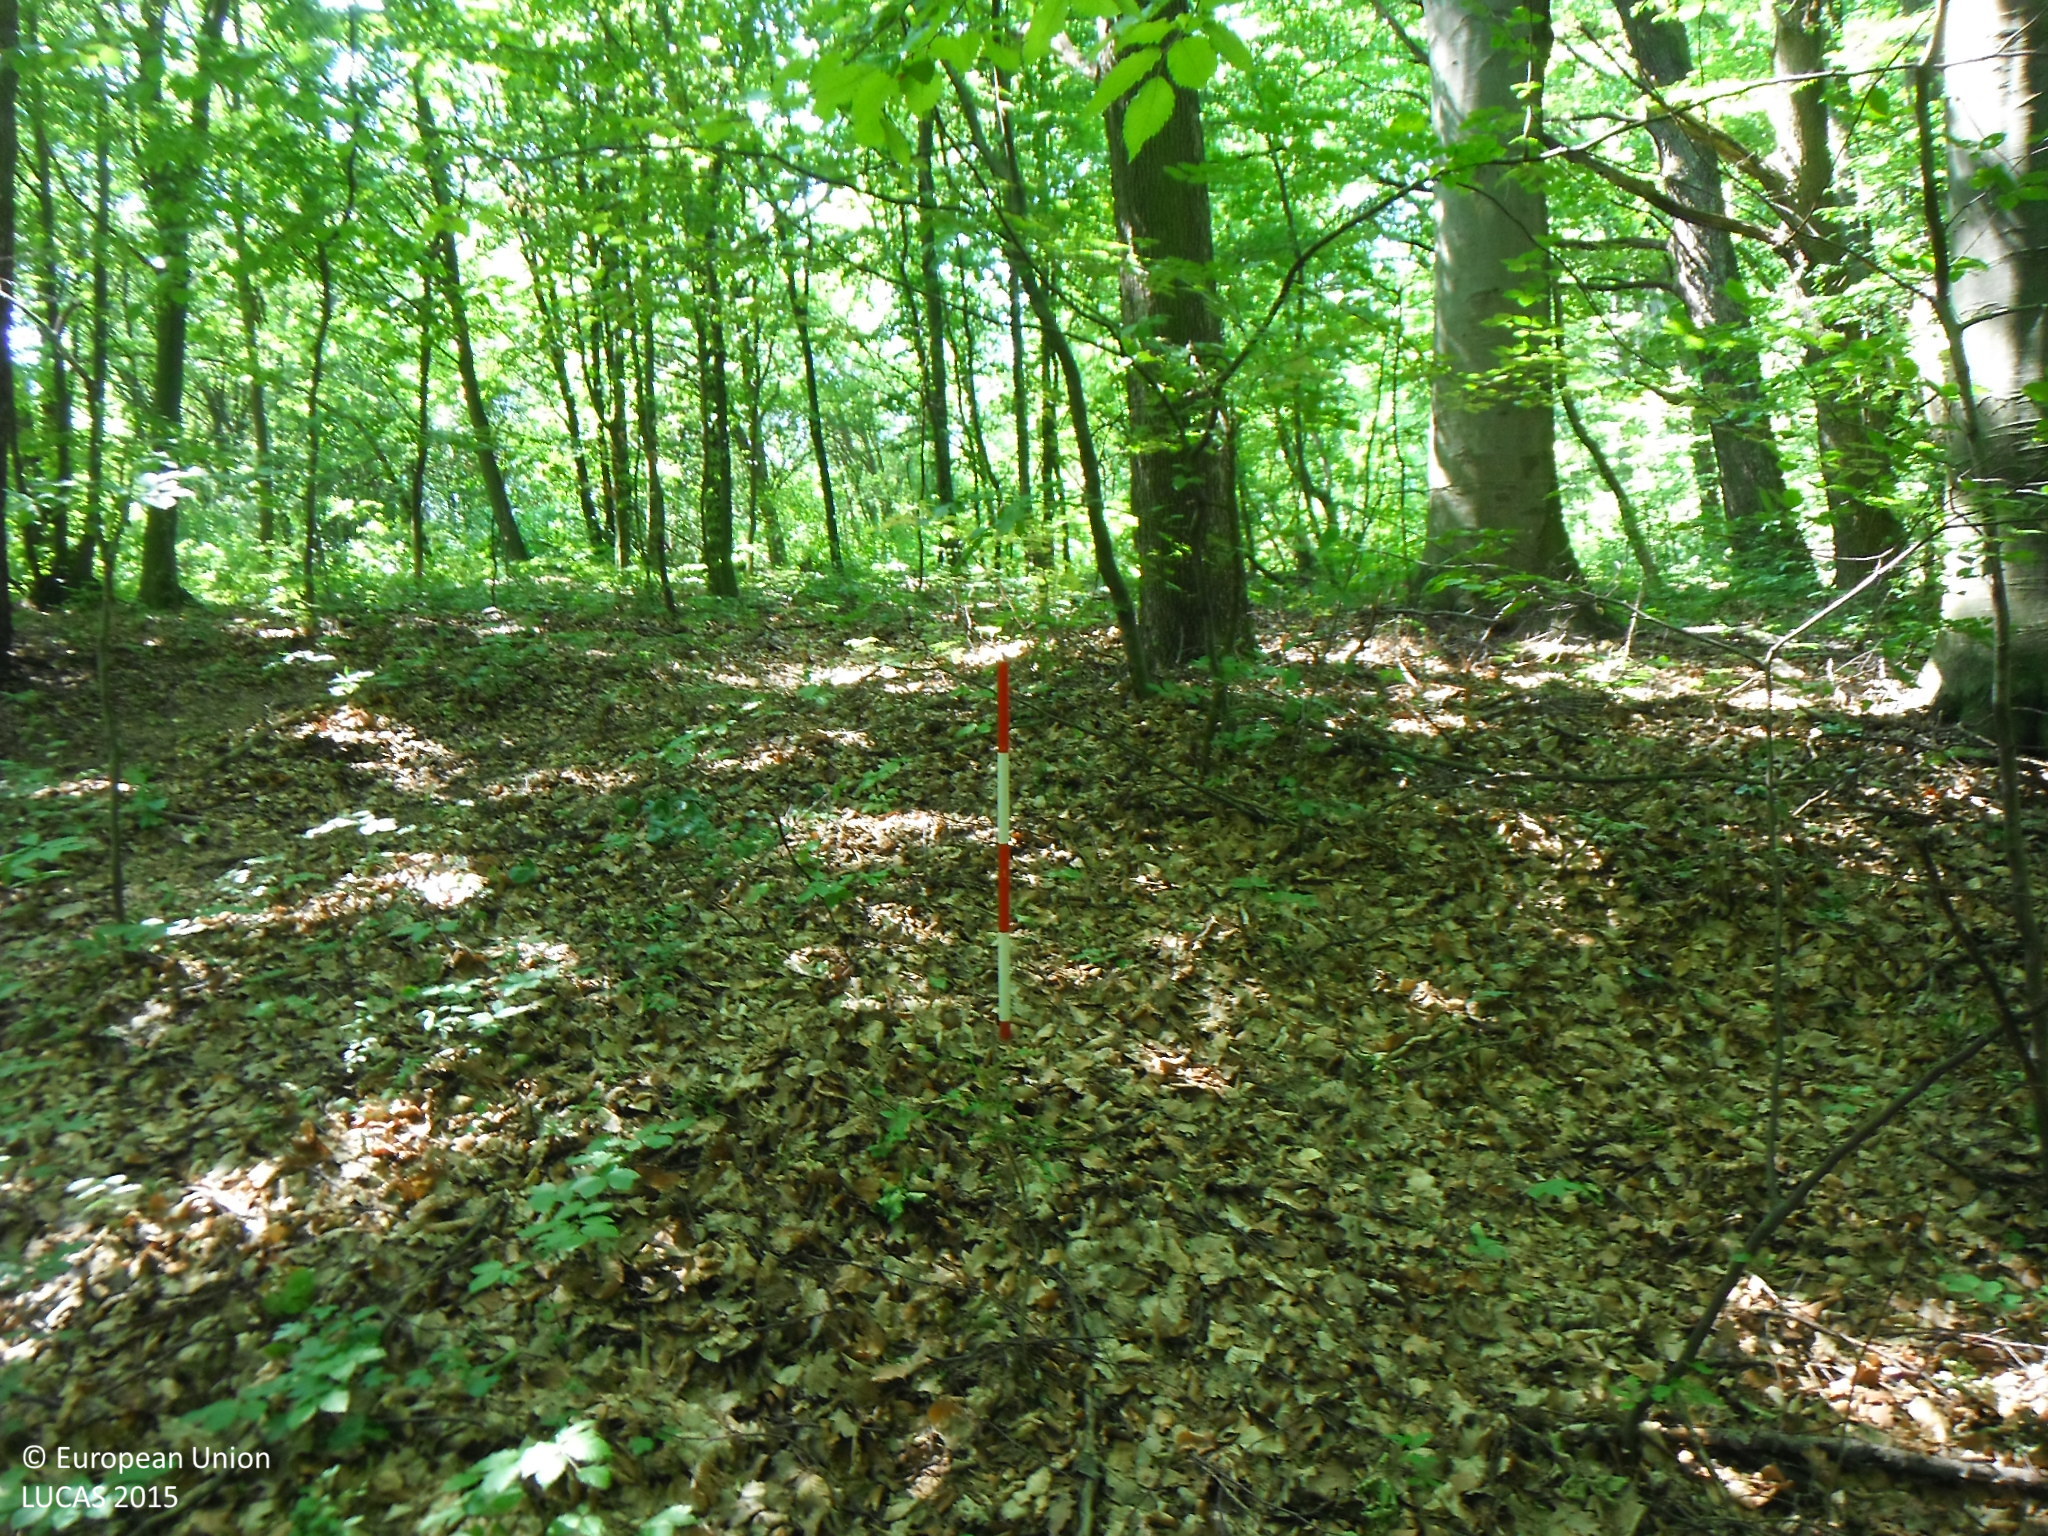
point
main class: Woodland
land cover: Broadleaved woodland
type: beech forest
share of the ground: > 75 %
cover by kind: broadleaved forest trees 95 %, shrubs 5 %
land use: Forestry
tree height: > 5 m
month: June
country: SK
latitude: 48.8674
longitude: 21.9005
